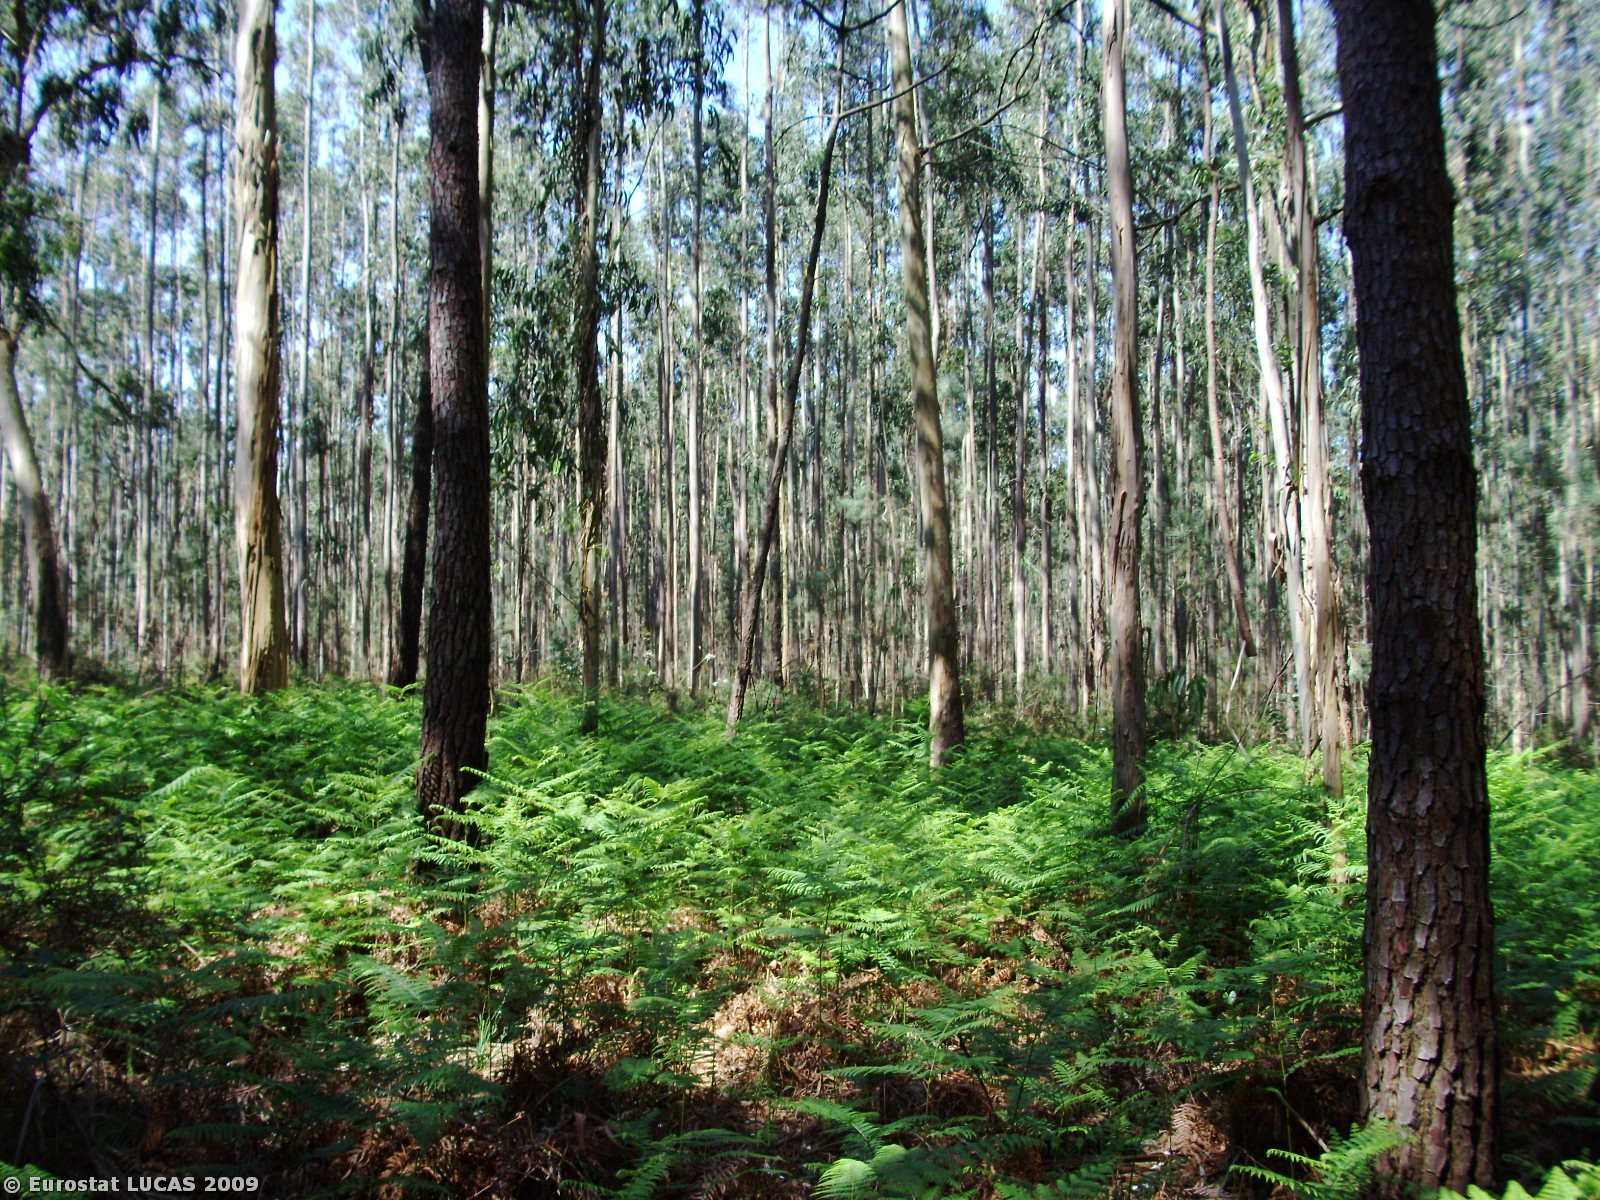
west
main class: Woodland
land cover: Mixed woodland
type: plantations and self-sown exotic forest
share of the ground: 50 - 75 %
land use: Forestry
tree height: > 5 m
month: May
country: PT
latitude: 40.7320
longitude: -8.4827
